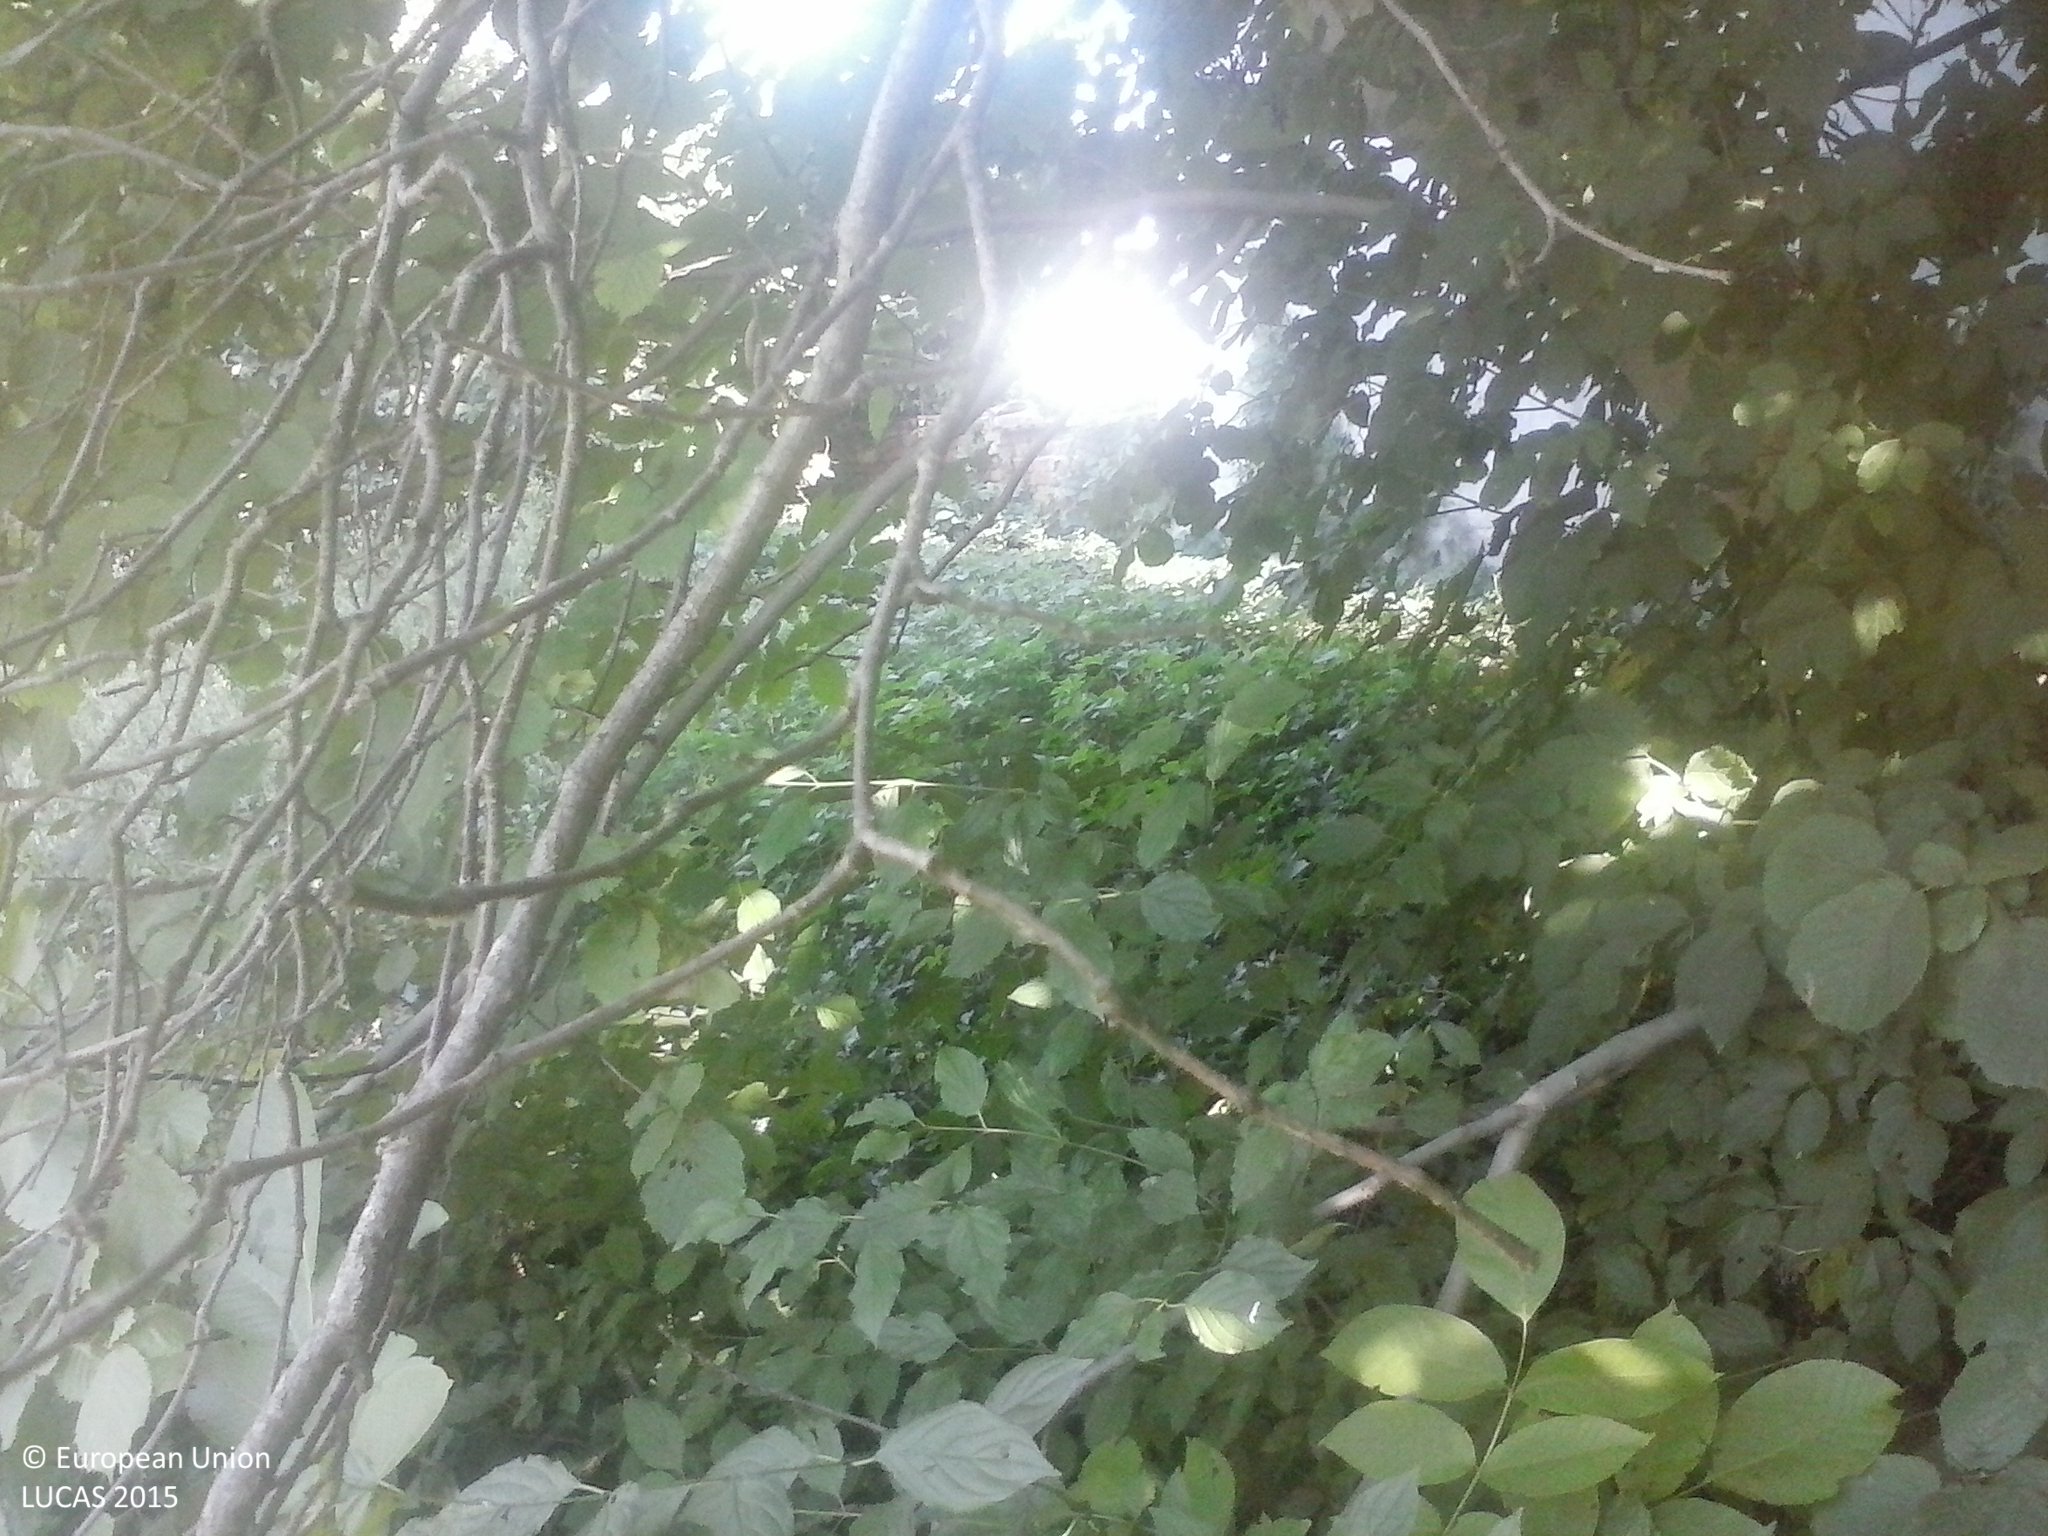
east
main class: Grassland
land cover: Grassland with sparse tree/shrub cover
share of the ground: > 75 %
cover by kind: herbaceous plants 90 %, broadleaved forest trees 5 %, shrubs 5 %
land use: Residential
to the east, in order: Grassland with sparse tree/shrub cover; Artificial constructions in urban areas
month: August
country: HU
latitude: 46.0482
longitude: 17.7978
